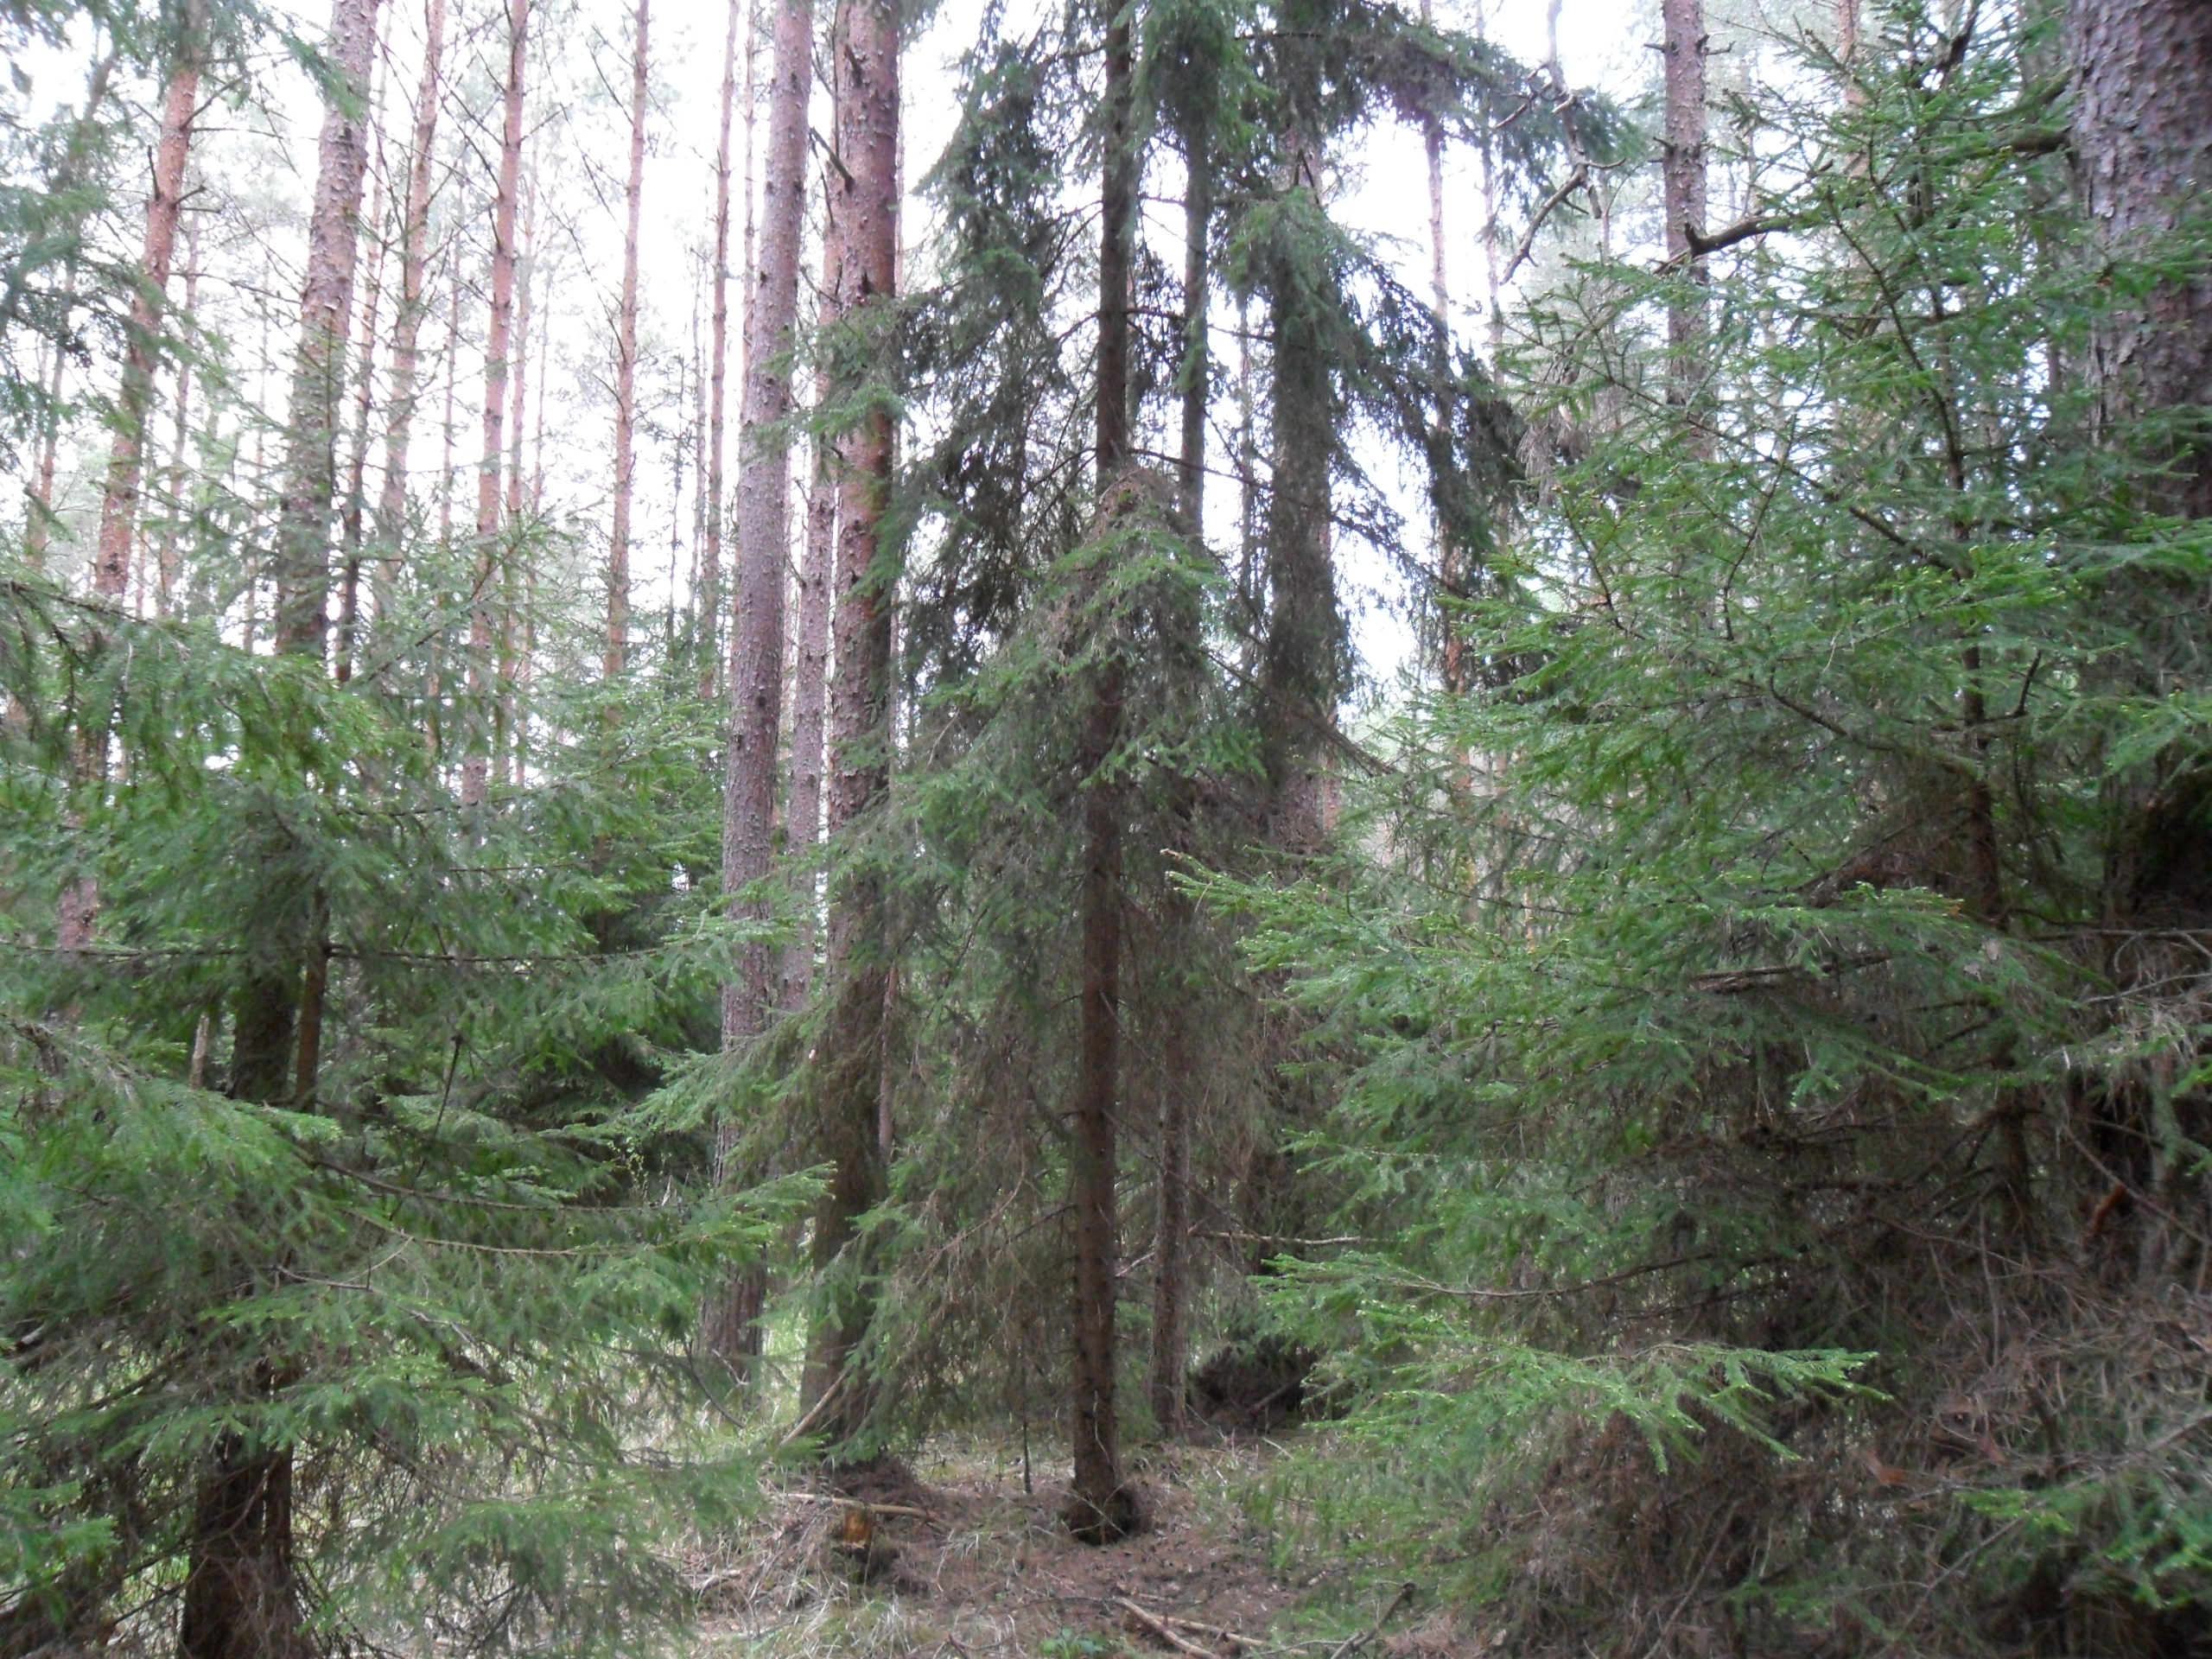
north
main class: Woodland
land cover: Other coniferous woodland
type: hemiboreal forest and nemoral coniferous forest and mixed broadleaved-coniferous forest
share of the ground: > 75 %
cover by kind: coniferous forest trees 100 %
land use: Forestry
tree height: > 5 m
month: May
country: LV
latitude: 57.2342
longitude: 23.0350
